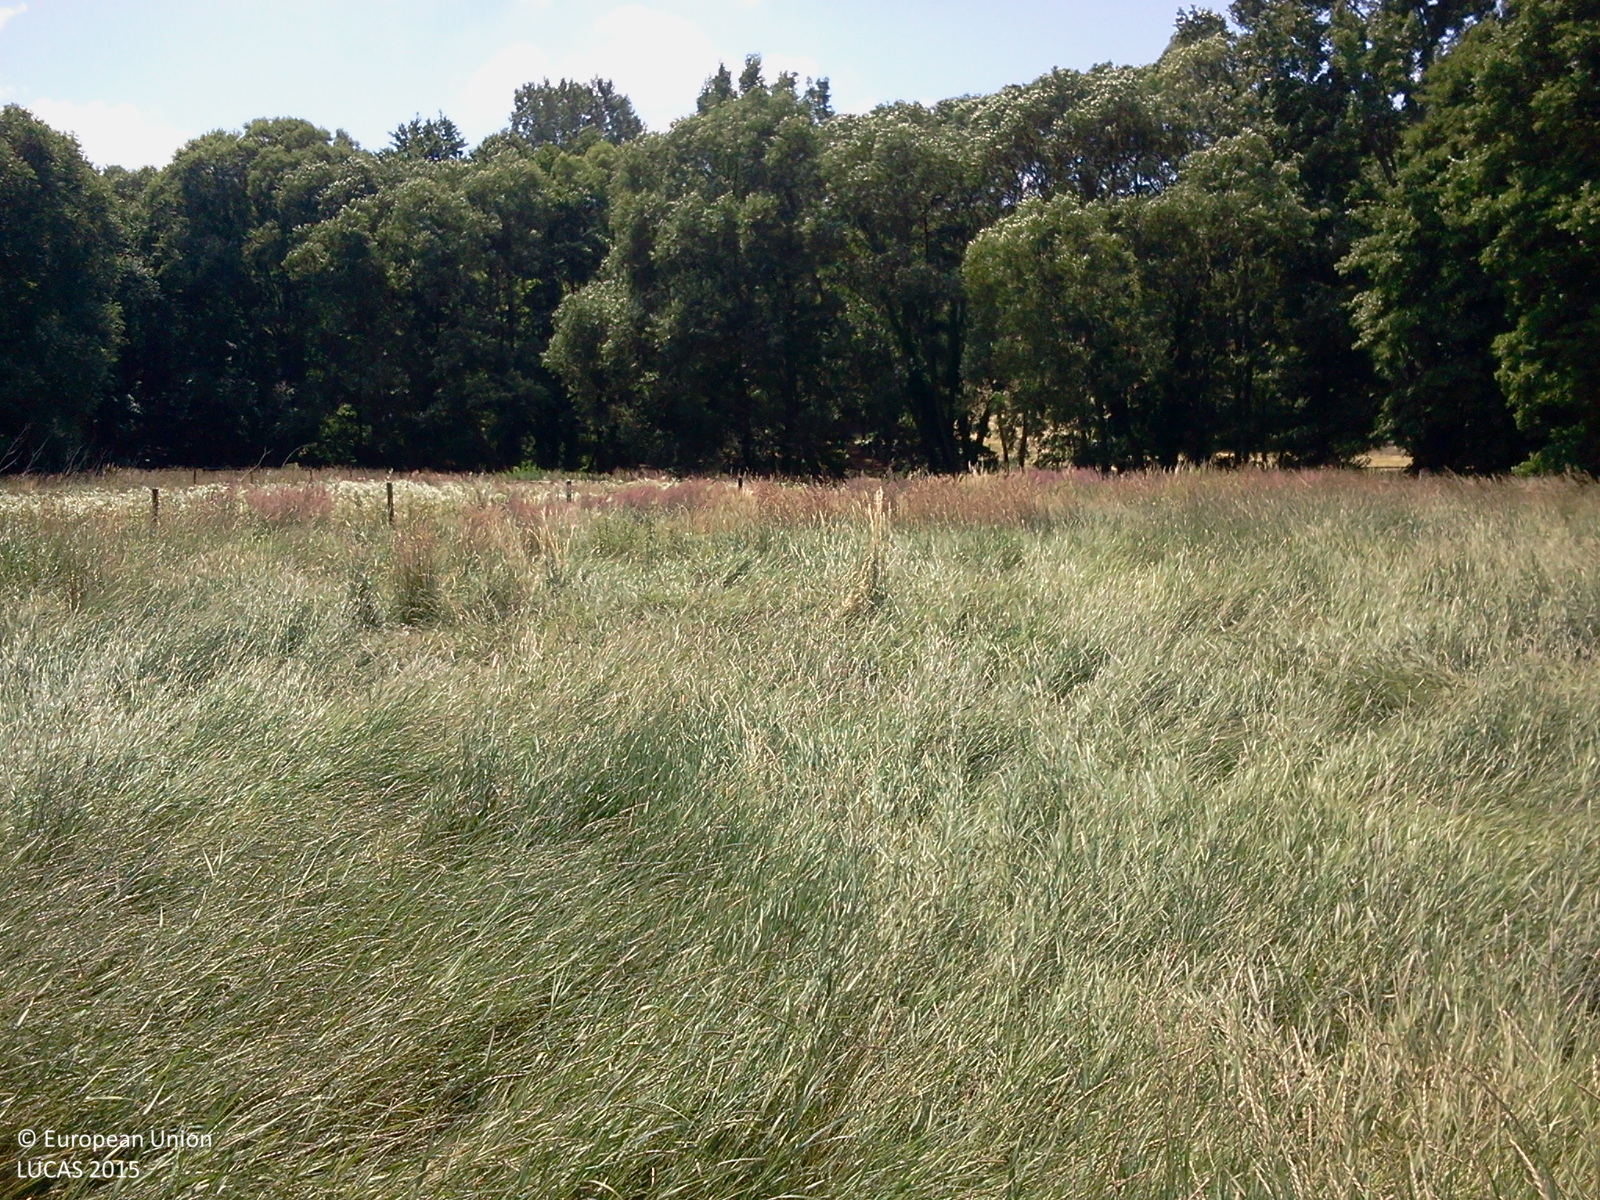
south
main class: Grassland
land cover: Grassland without tree/shrub cover
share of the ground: > 75 %
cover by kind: herbaceous plants 100 %
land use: Agriculture (excluding fallow land and kitchen gardens)
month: June
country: HU
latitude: 46.8025
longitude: 17.0929
